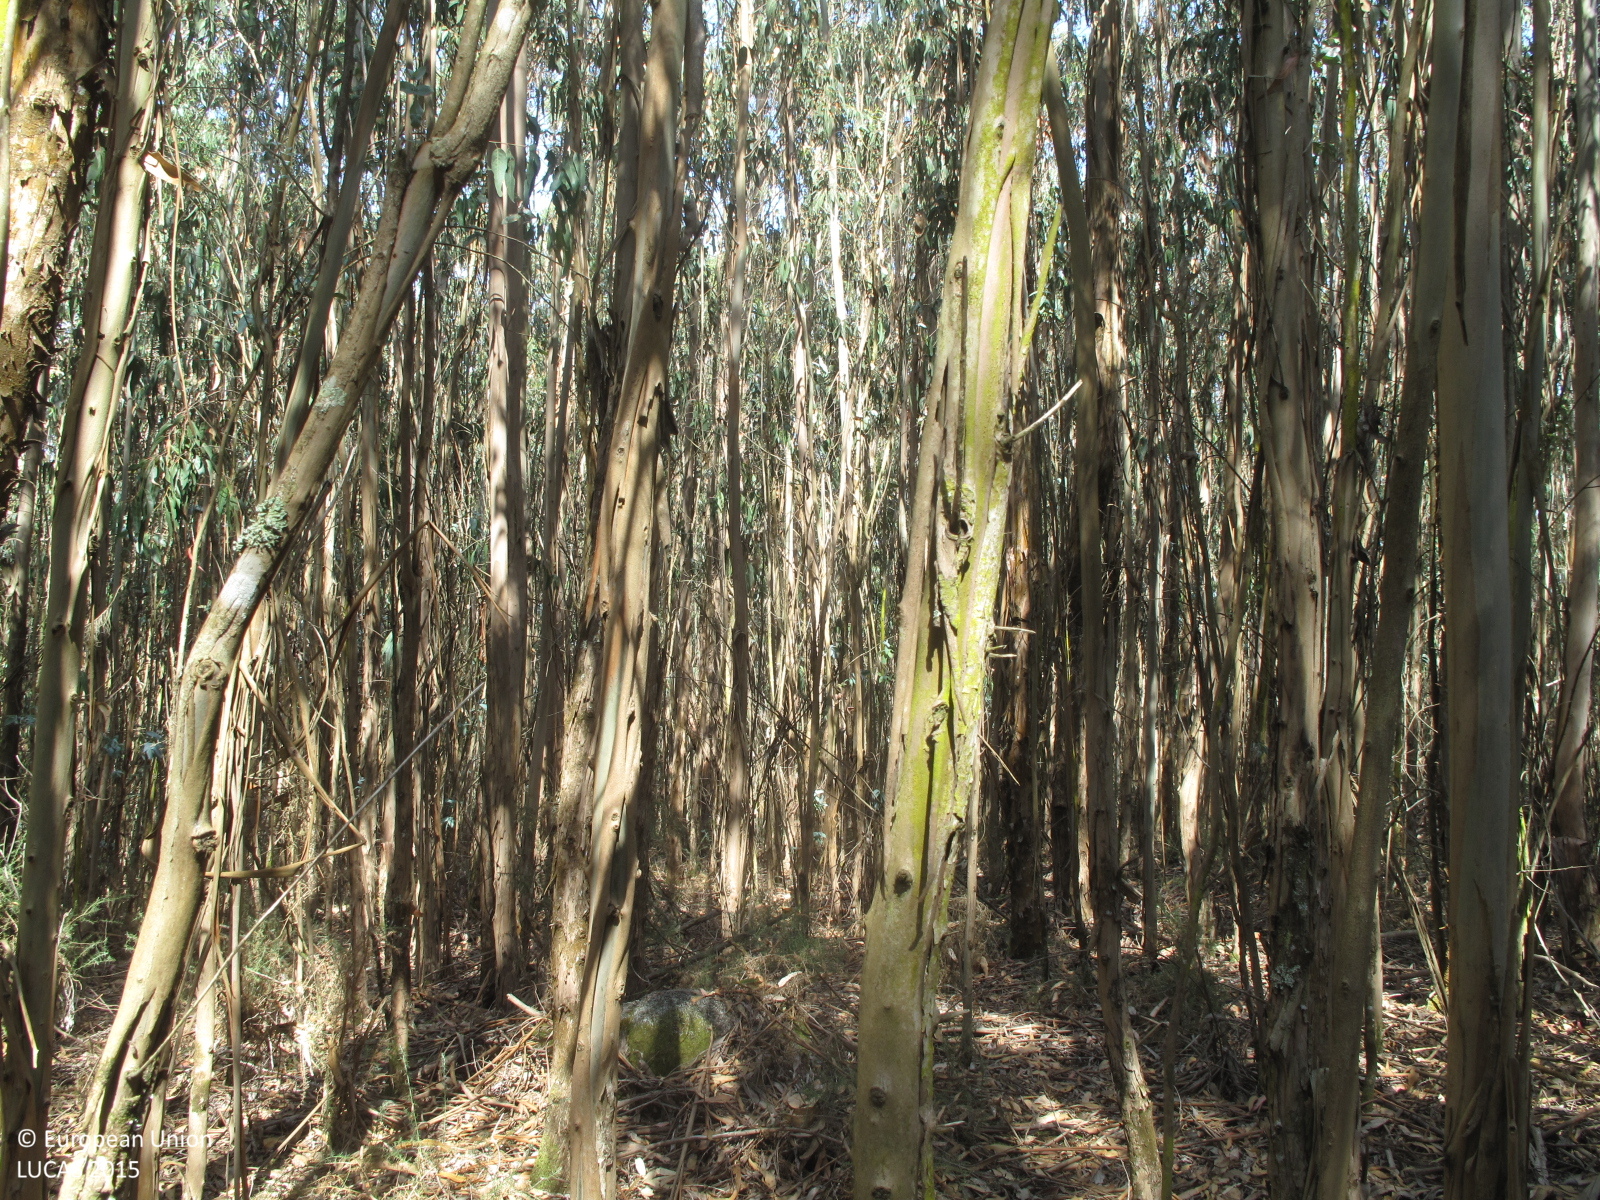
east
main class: Woodland
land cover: Broadleaved woodland
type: exotic forest
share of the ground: > 75 %
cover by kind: broadleaved forest trees 90 %, shrubs 5 %, unconsolidated bare surface 5 %
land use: Forestry
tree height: > 5 m
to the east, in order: Broadleaved woodland; Tracks; Broadleaved woodland; Tracks; Broadleaved woodland; Tracks; Broadleaved woodland
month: July
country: ES
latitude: 43.4435
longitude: -8.3050
